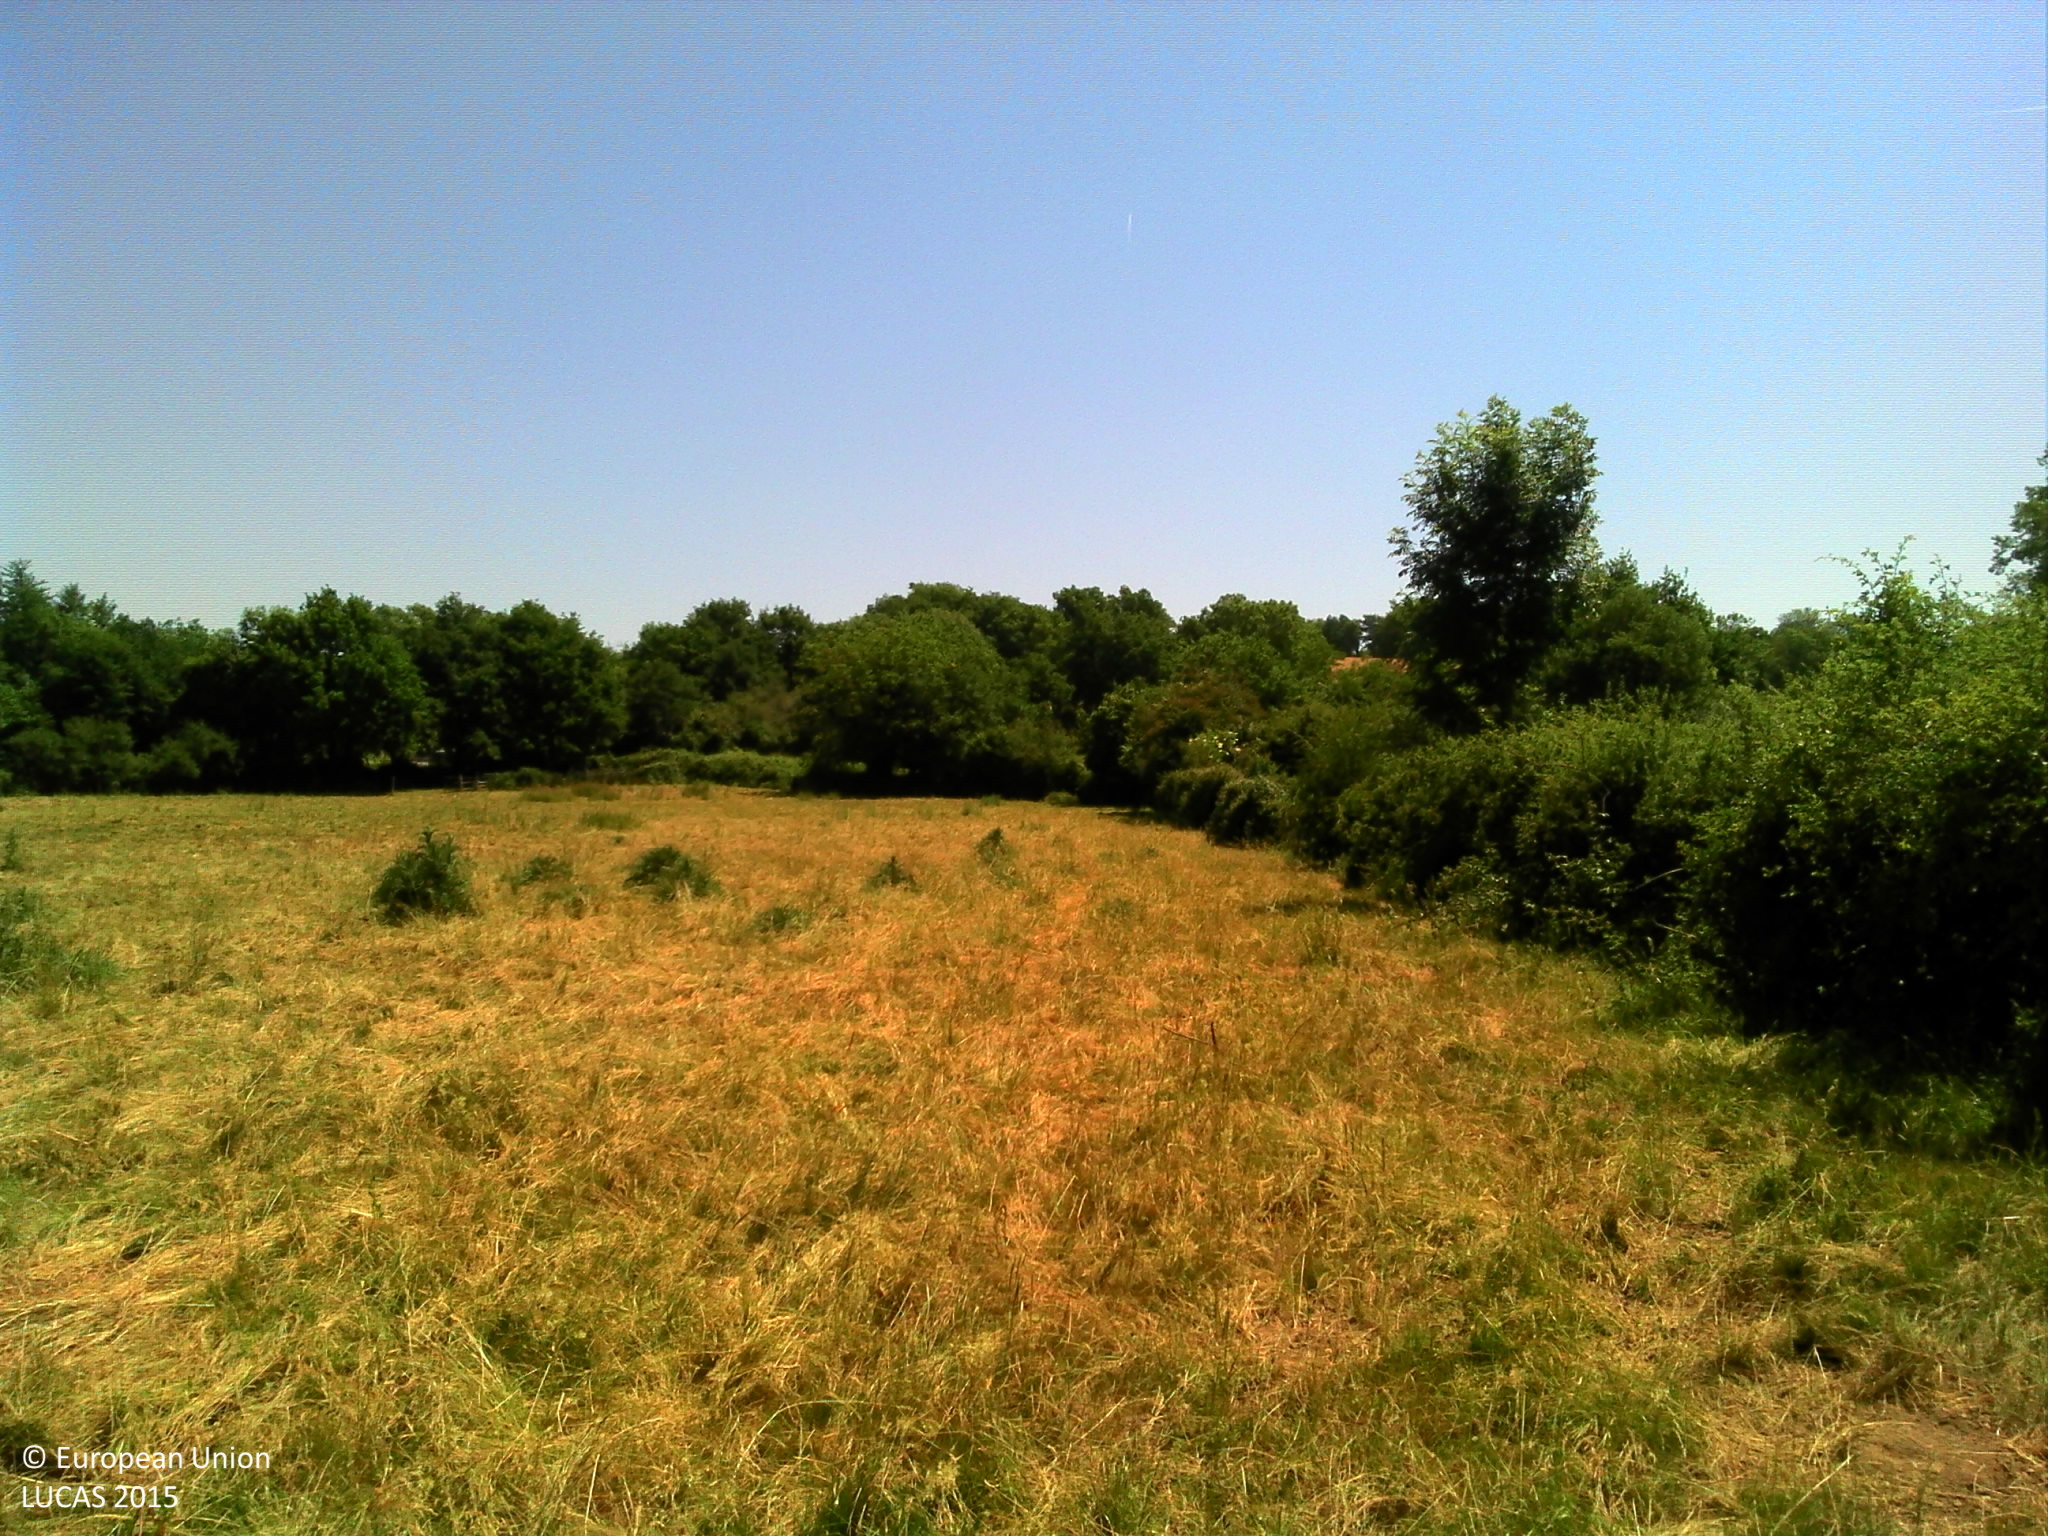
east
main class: Grassland
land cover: Grassland without tree/shrub cover
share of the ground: > 75 %
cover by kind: herbaceous plants 100 %
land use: Agriculture (excluding fallow land and kitchen gardens)
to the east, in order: Grassland without tree/shrub cover; Fences; Broadleaved woodland; Spontaneously vegetated surfaces; Ditches and canals; Broadleaved woodland; Electric lines; Grass margins; Paved roads, cycling and walking lanes; Grass margins; Grassland without tree/shrub cover
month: June
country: FR
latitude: 46.1070
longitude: 0.6837
